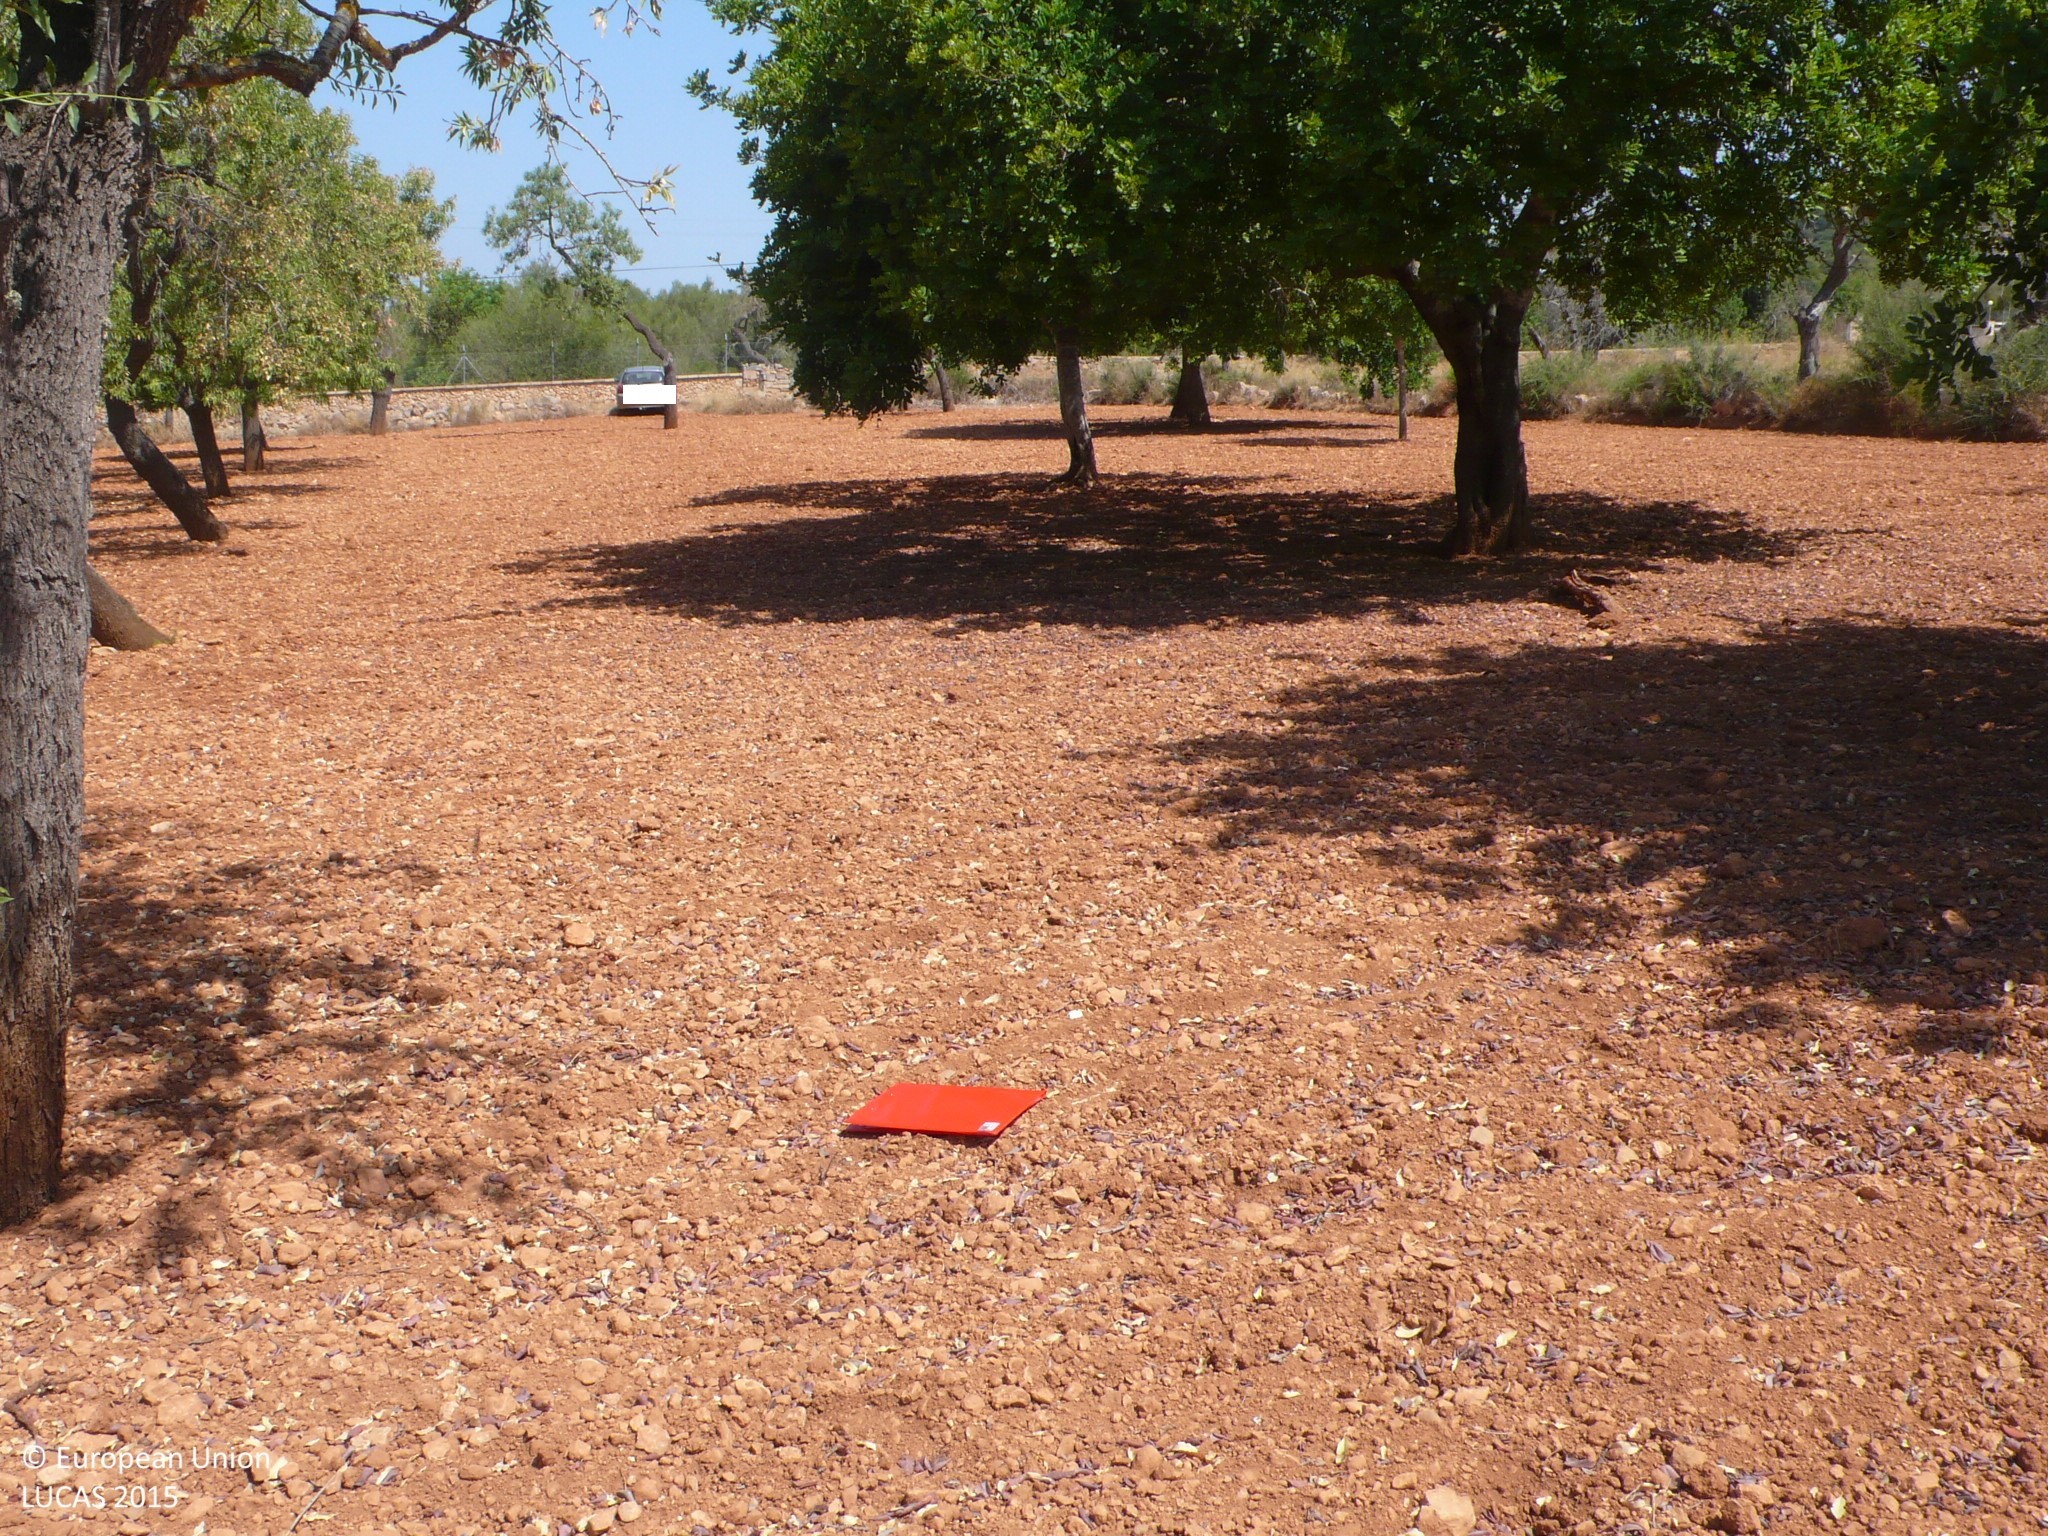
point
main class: Cropland
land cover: Nuts trees
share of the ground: 25 - 50 %
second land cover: Other bare soil
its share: > 75 %
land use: Agriculture (excluding fallow land and kitchen gardens)
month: July
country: ES
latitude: 39.5177
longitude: 2.8771
